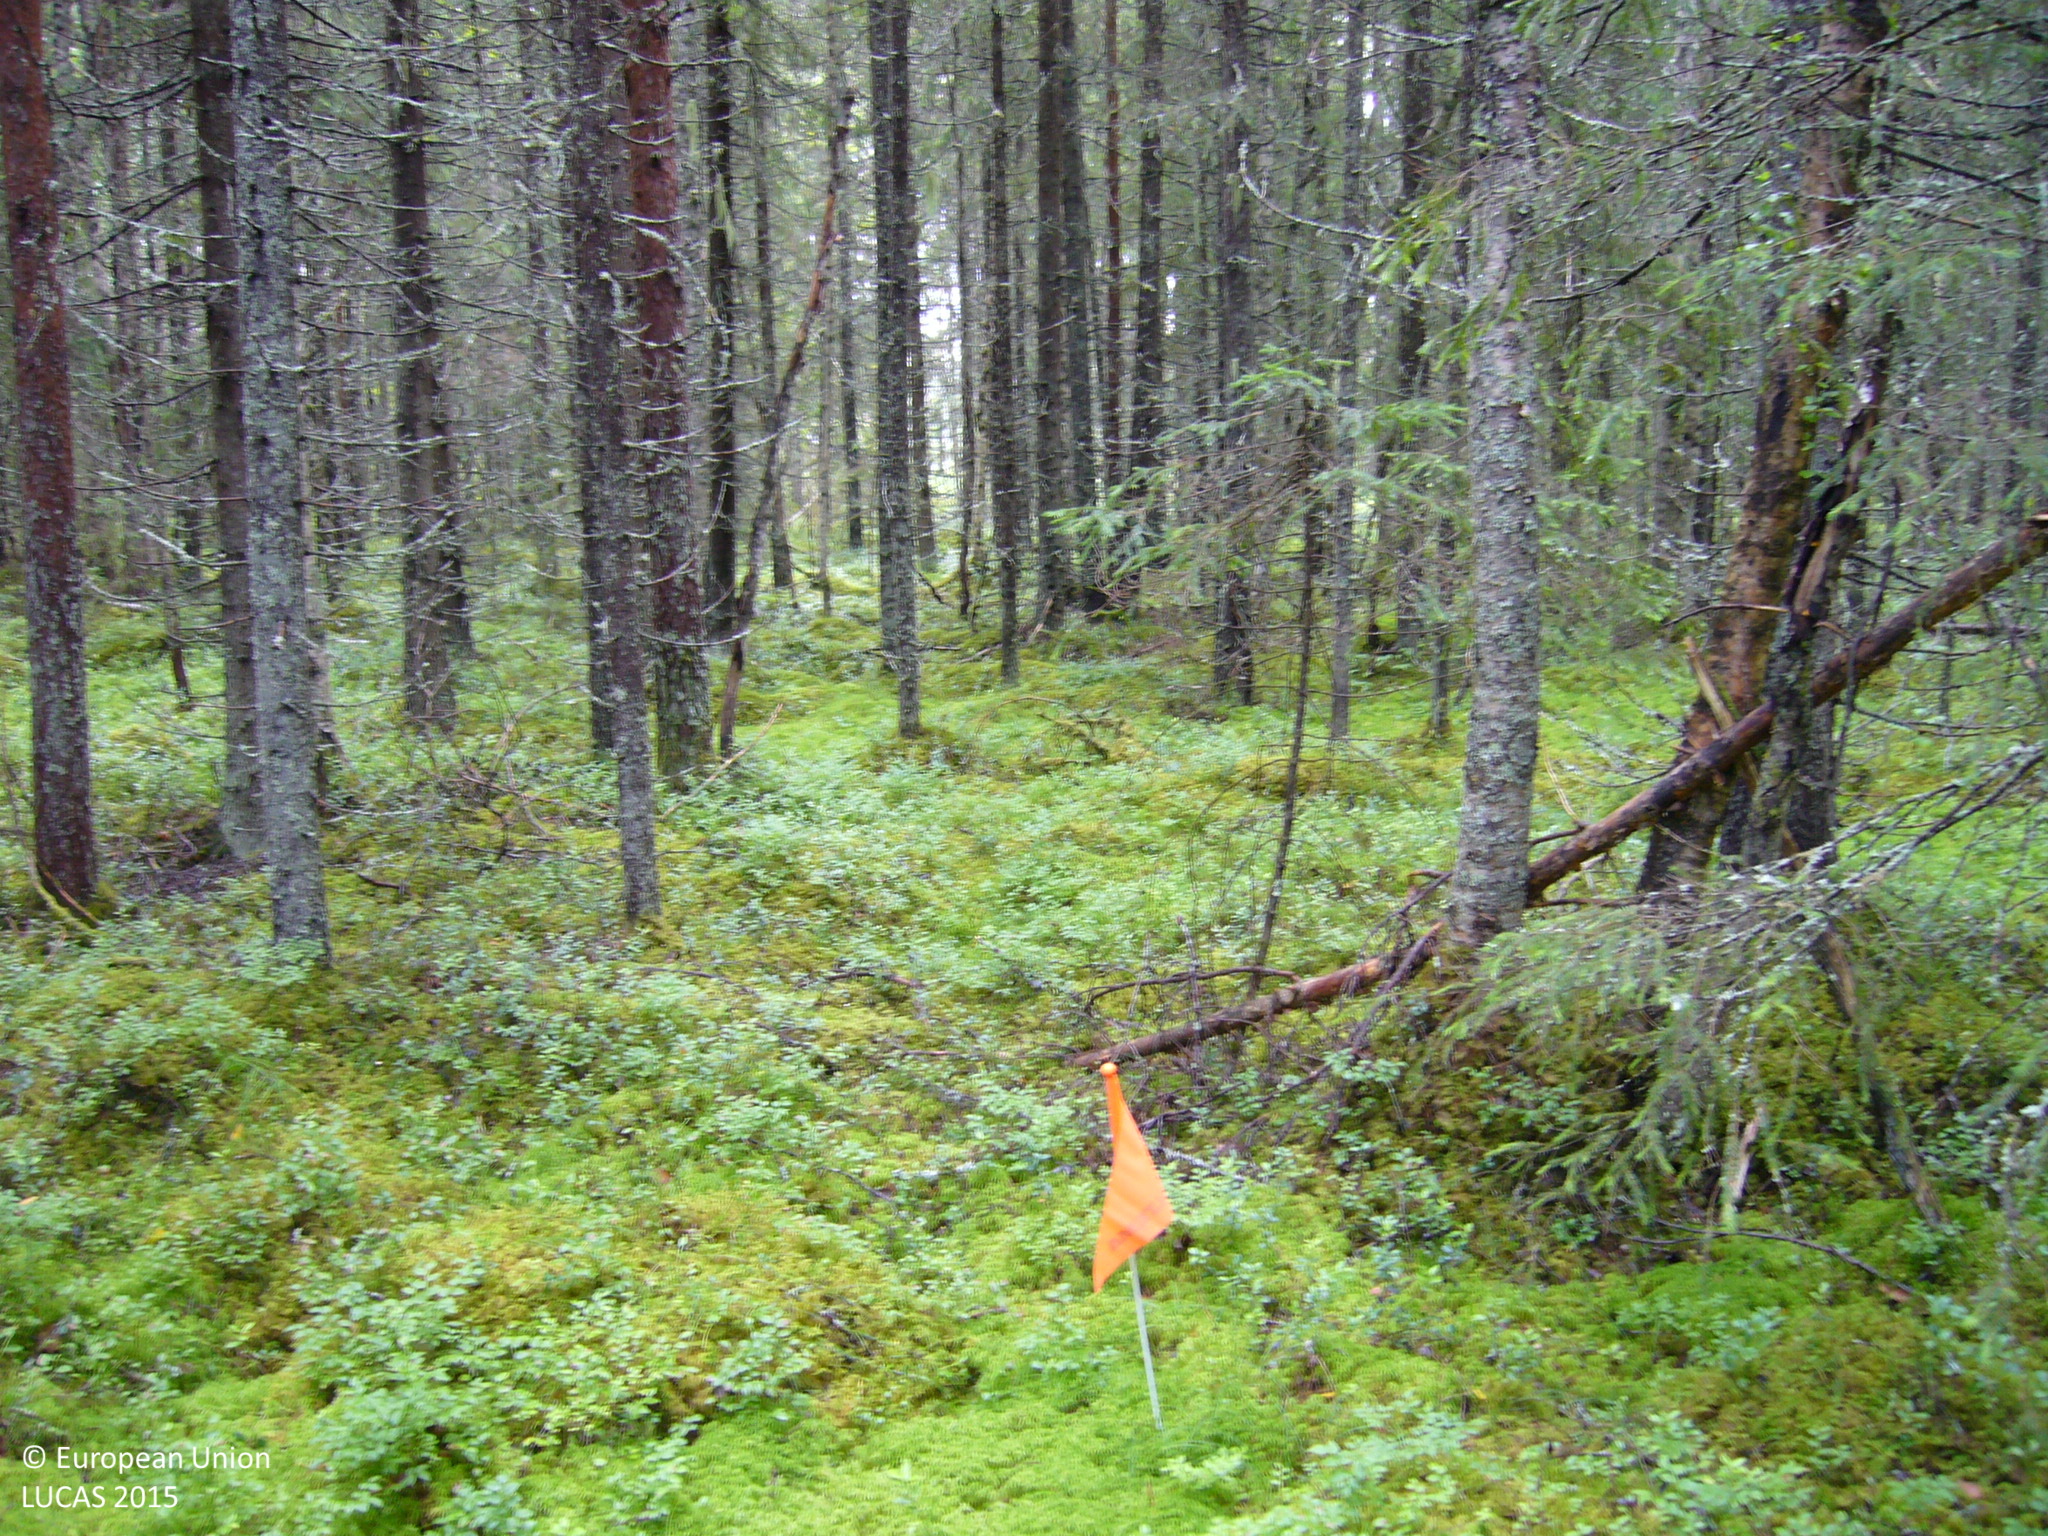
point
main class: Woodland
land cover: Spruce dominated mixed woodland
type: boreal forest
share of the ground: > 75 %
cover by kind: coniferous forest trees 50 %, broadleaved forest trees 30 %, shrubs 20 %
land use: Forestry
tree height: > 5 m
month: July
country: FI
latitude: 63.8832
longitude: 25.5523
